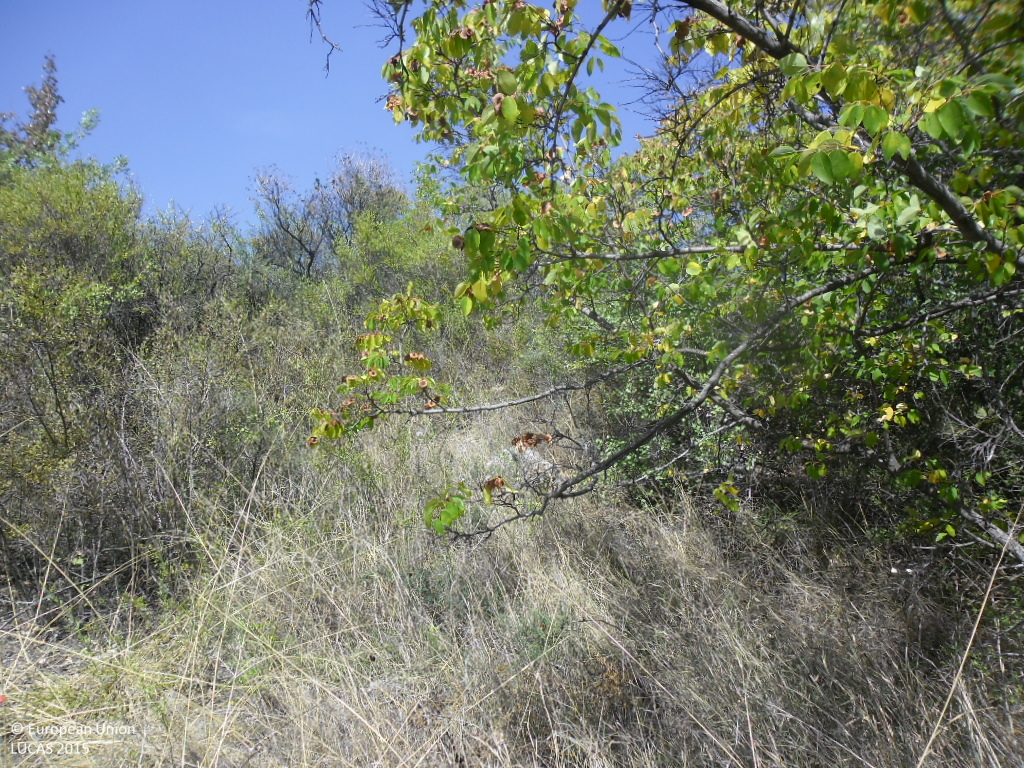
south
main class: Woodland
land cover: Broadleaved woodland
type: thermophilous deciduous forest
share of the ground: > 75 %
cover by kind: broadleaved forest trees 85 %, unconsolidated bare surface 10 %, coniferous forest trees 5 %
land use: Forestry
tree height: < 5 m
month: September
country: BG
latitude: 41.6732
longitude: 23.2230
